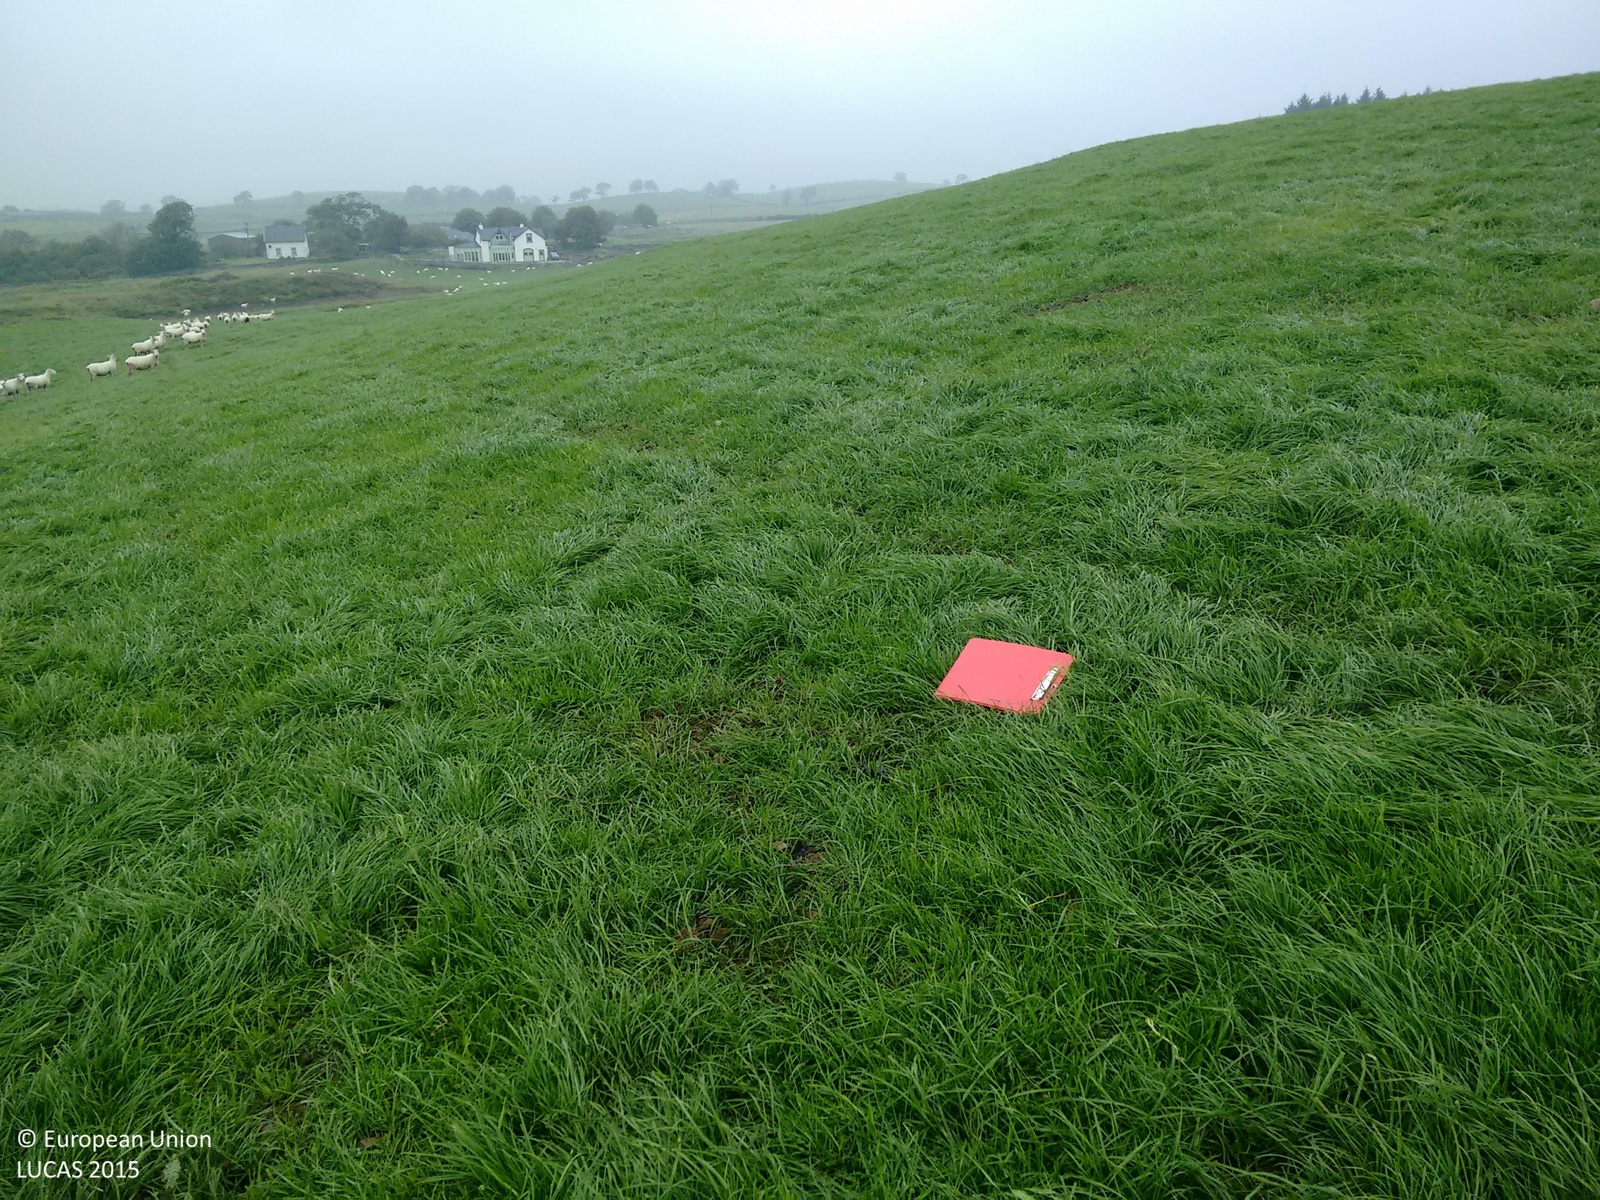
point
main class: Grassland
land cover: Grassland without tree/shrub cover
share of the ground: > 75 %
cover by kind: herbaceous plants 100 %
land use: Agriculture (excluding fallow land and kitchen gardens)
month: July
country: GB
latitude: 54.7994
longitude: -4.1091
